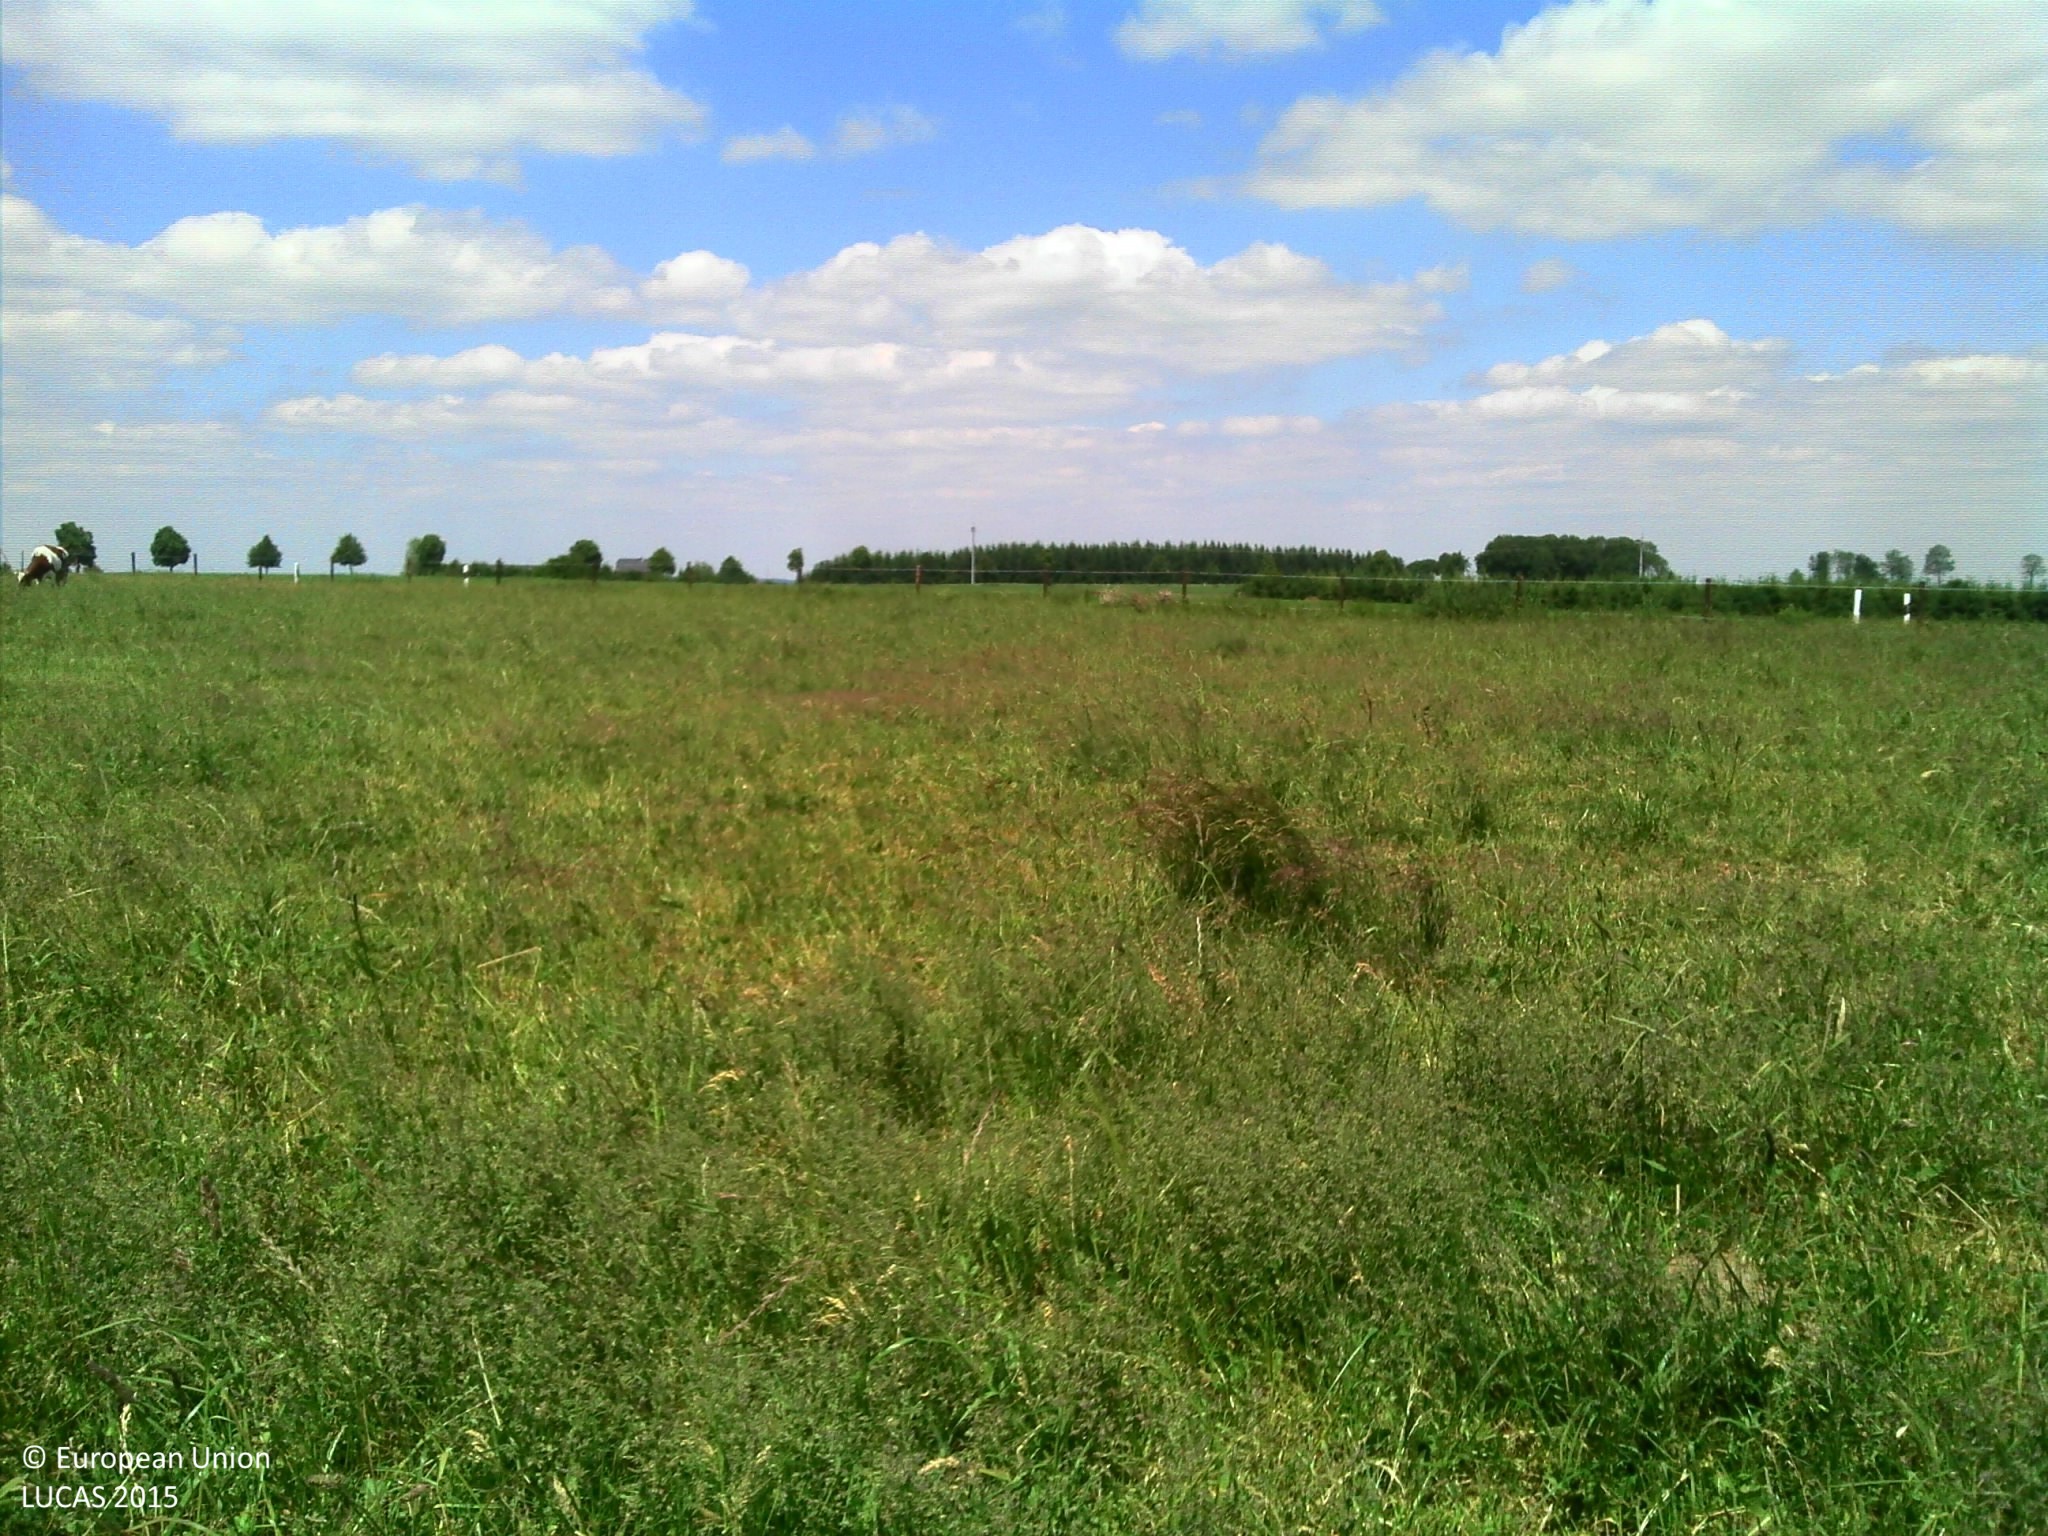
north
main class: Grassland
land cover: Grassland without tree/shrub cover
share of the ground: > 75 %
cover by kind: herbaceous plants 100 %
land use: Agriculture (excluding fallow land and kitchen gardens)
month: June
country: LU
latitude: 49.8783
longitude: 5.9496
